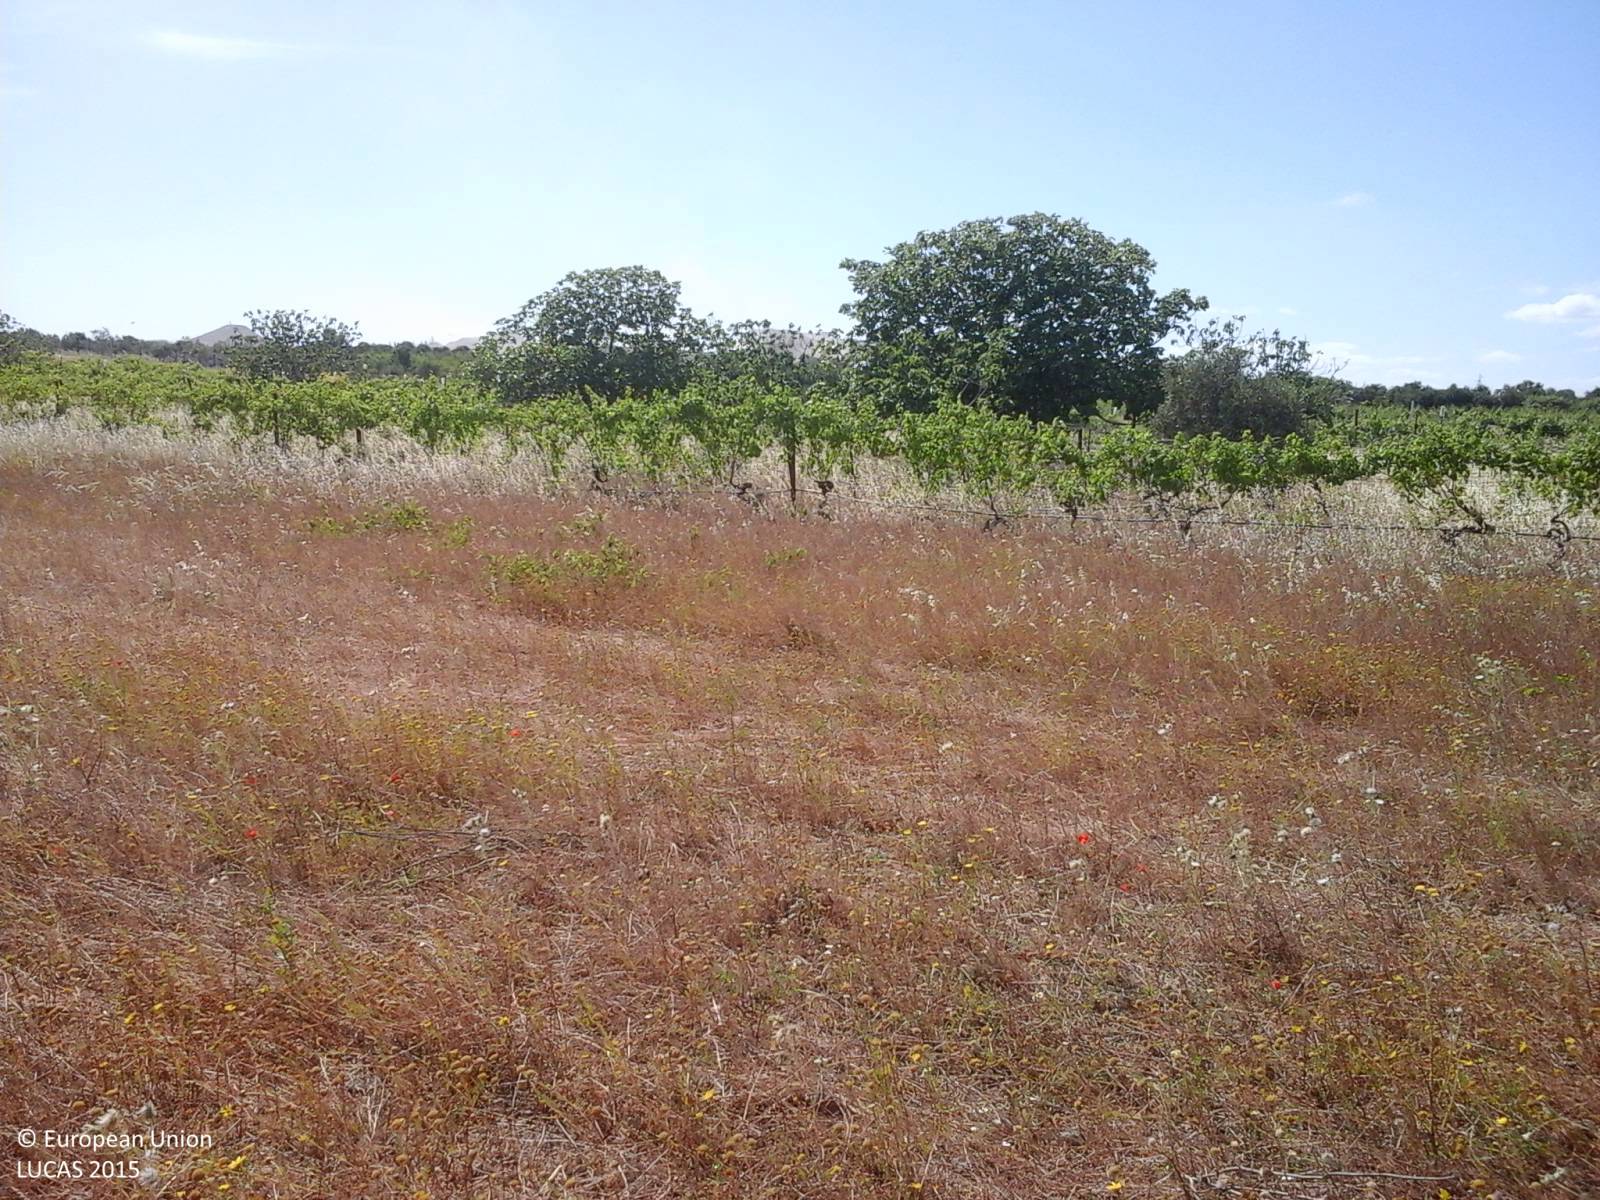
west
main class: Grassland
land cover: Spontaneously vegetated surfaces
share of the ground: > 75 %
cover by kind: herbaceous plants 100 %
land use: Fallow land
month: May
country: IT
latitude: 39.2681
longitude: 9.2282
